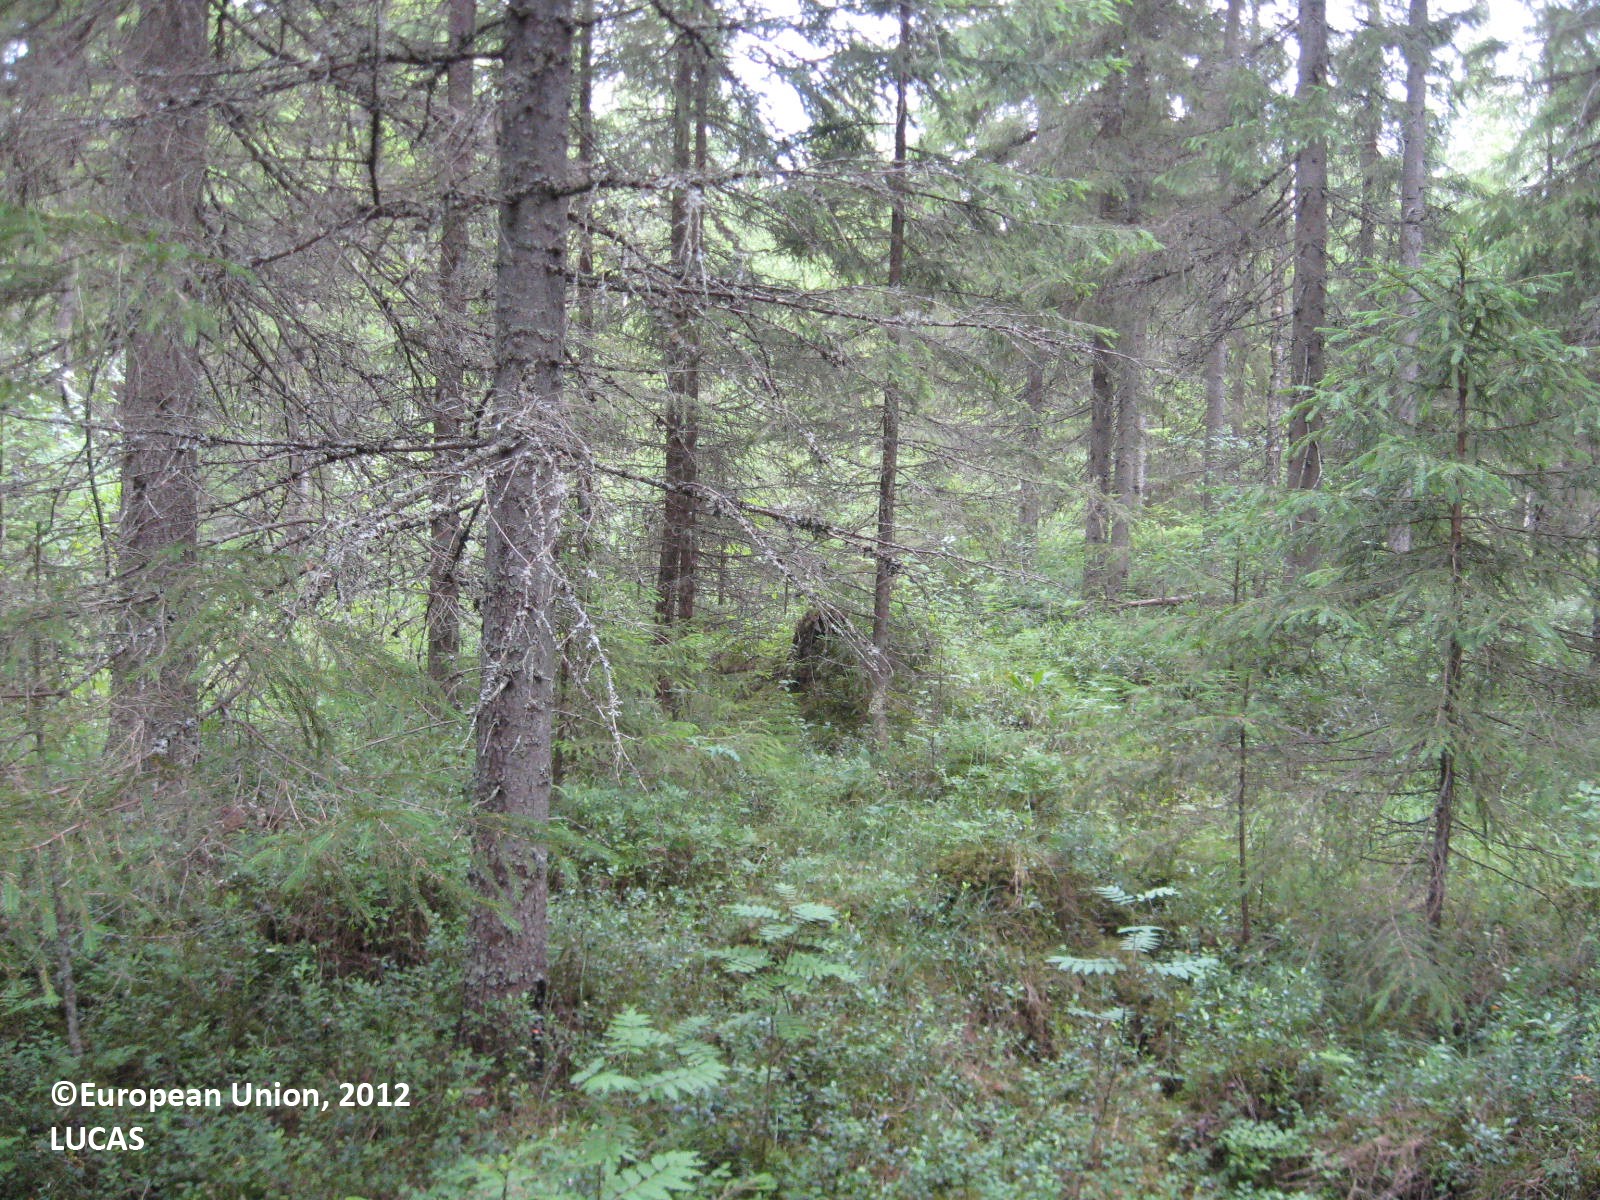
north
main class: Woodland
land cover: Spruce dominated coniferous woodland
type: boreal forest
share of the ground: > 75 %
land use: Forestry
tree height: > 5 m
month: July
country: FI
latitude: 62.5125
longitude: 21.5604
